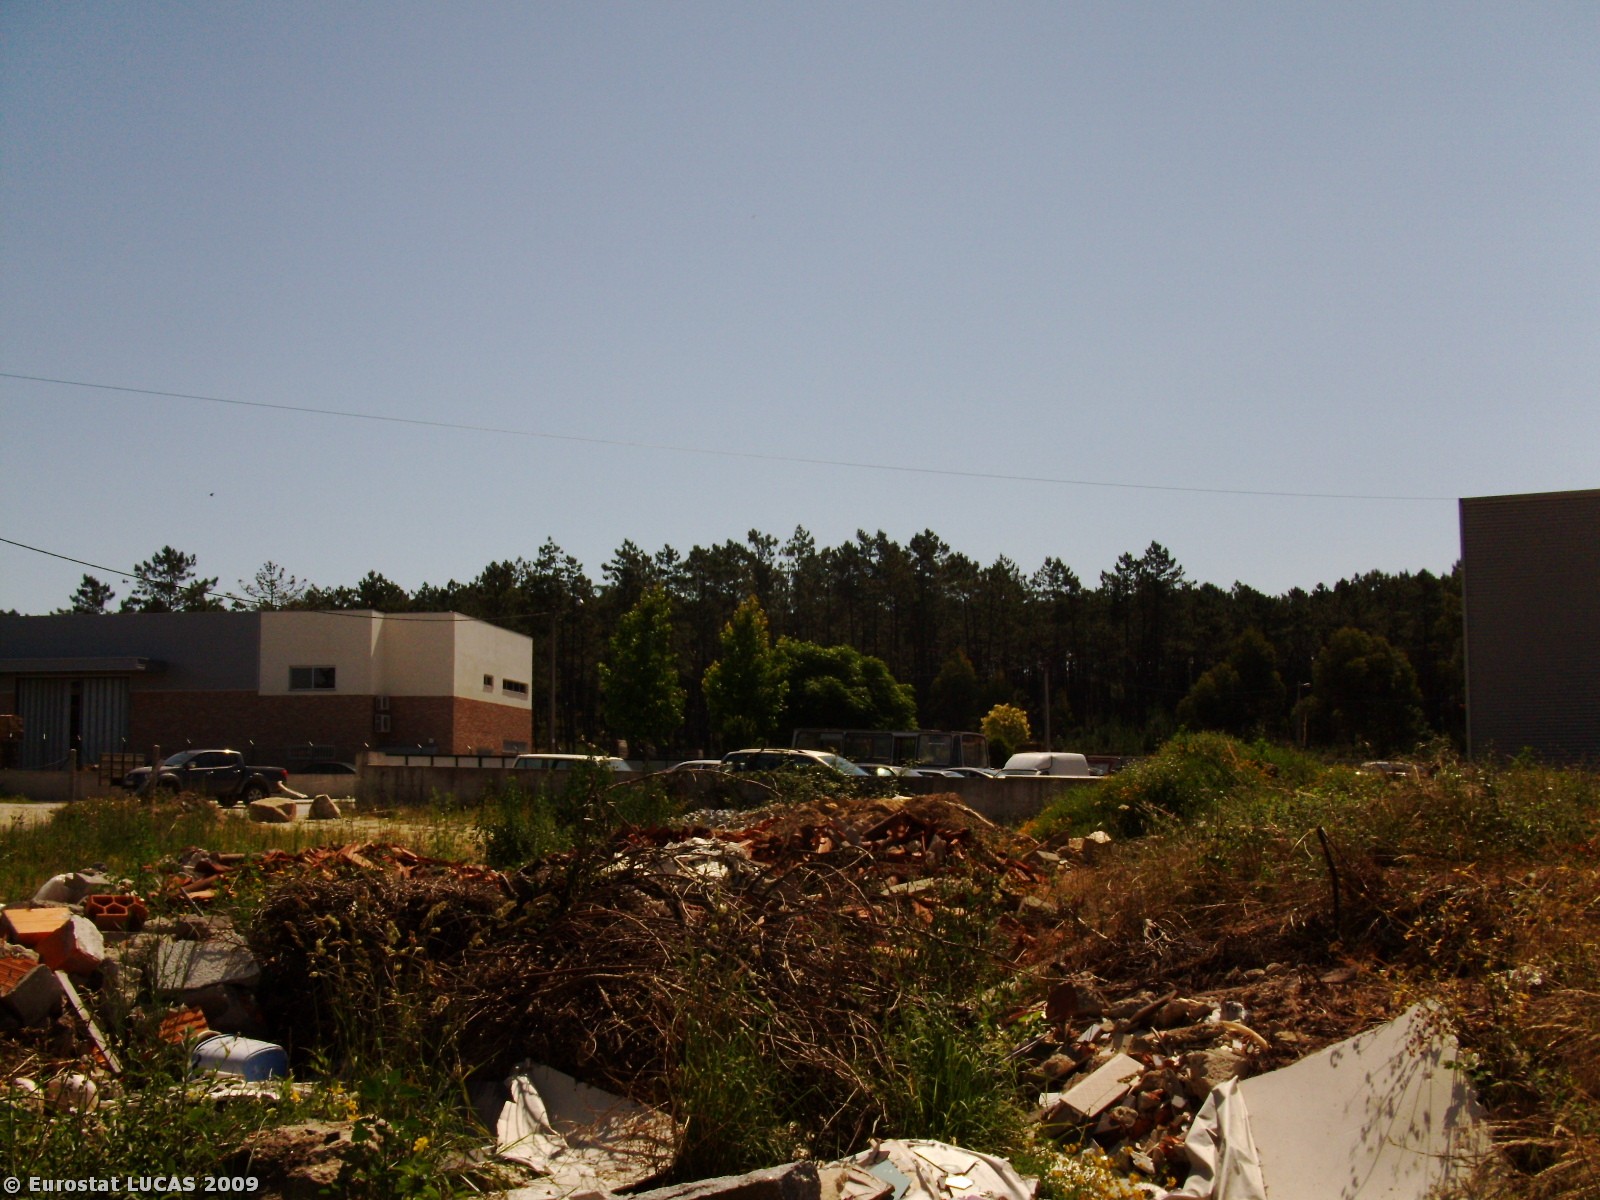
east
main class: Grassland
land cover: Spontaneously vegetated surfaces
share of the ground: 50 - 75 %
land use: Forestry
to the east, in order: Spontaneously vegetated surfaces; Bare land; Spontaneously vegetated surfaces; Artificial constructions in urban areas; Paved roads, cycling and walking lanes; Electric lines; Other structural elements; Fences; Artificial constructions in urban areas; Spontaneously vegetated surfaces; Fences; Paved roads, cycling and walking lanes; Grass margins; Coniferous woodland
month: July
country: PT
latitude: 41.5579
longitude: -8.5135
